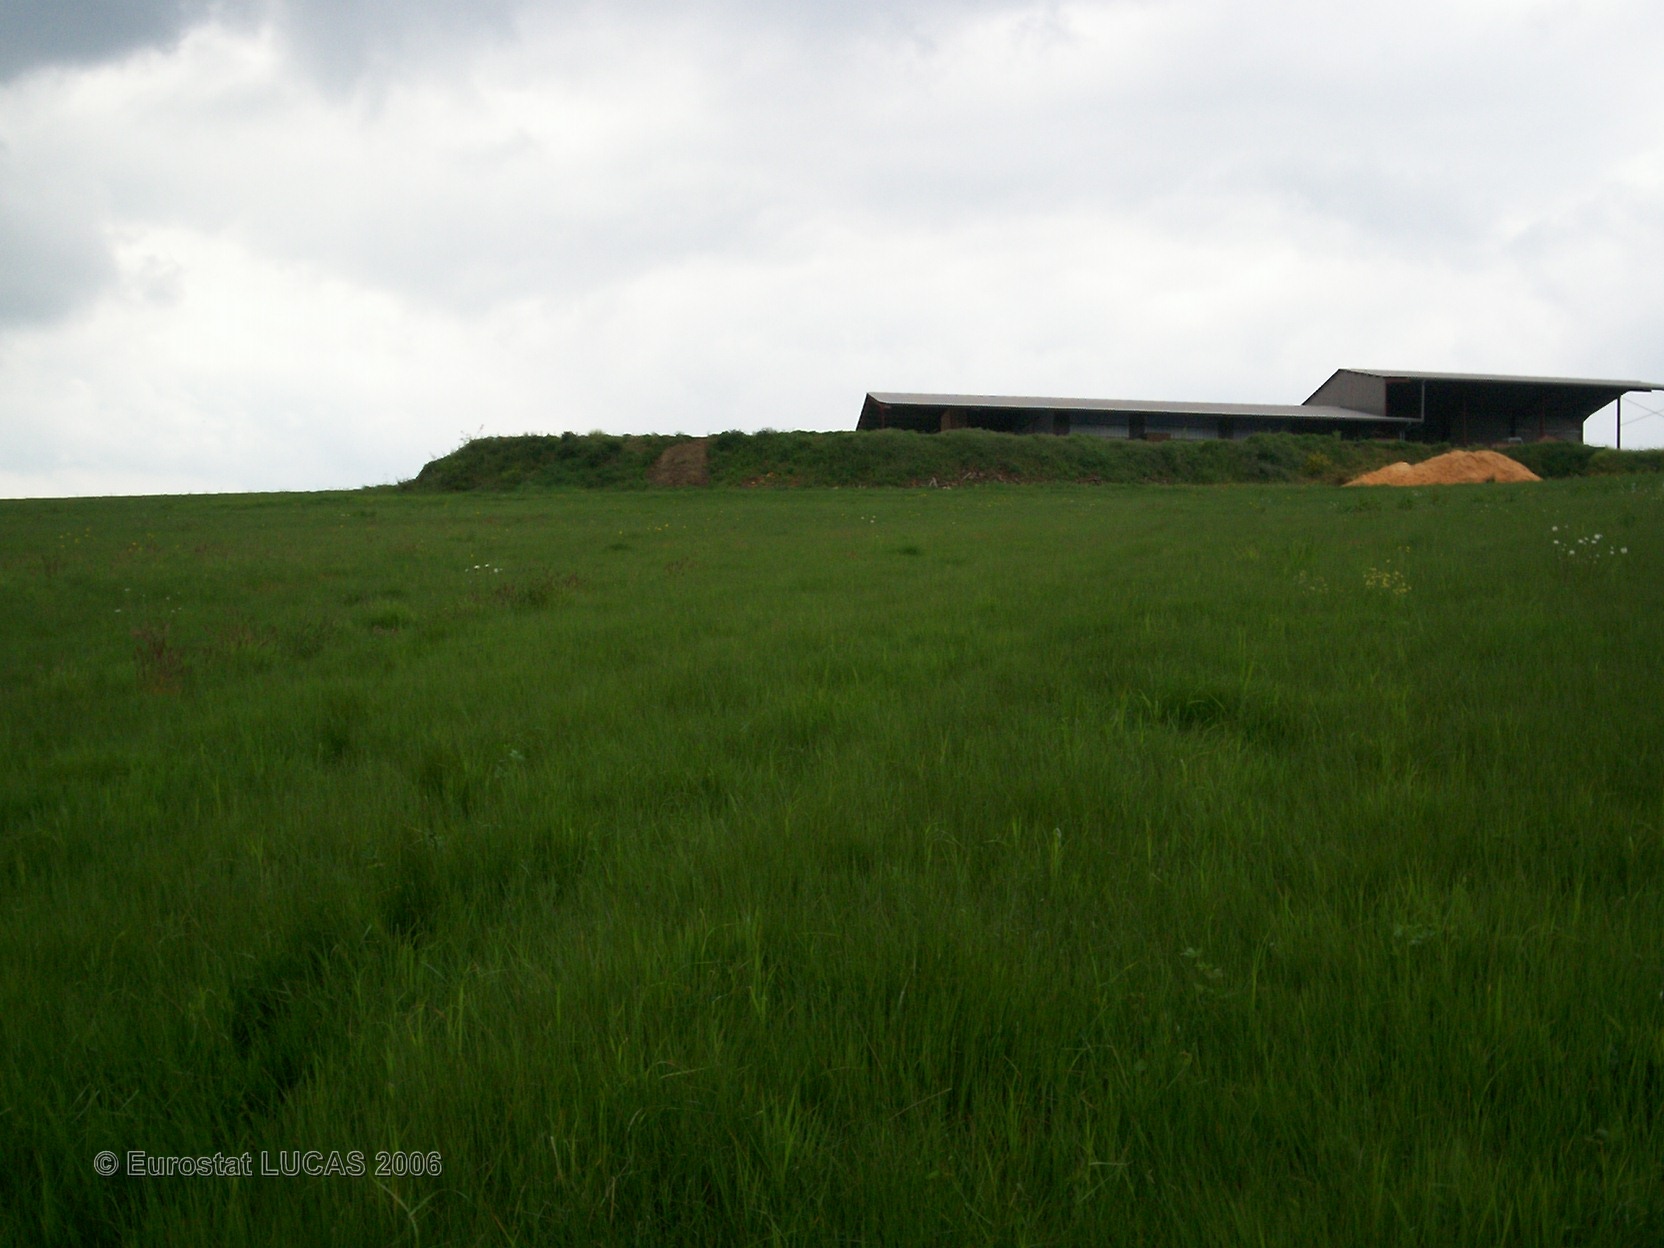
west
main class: Grassland
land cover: Grassland without tree/shrub cover
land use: Agriculture (excluding fallow land and kitchen gardens)
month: May
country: FR
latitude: 45.7317
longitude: 0.5412
